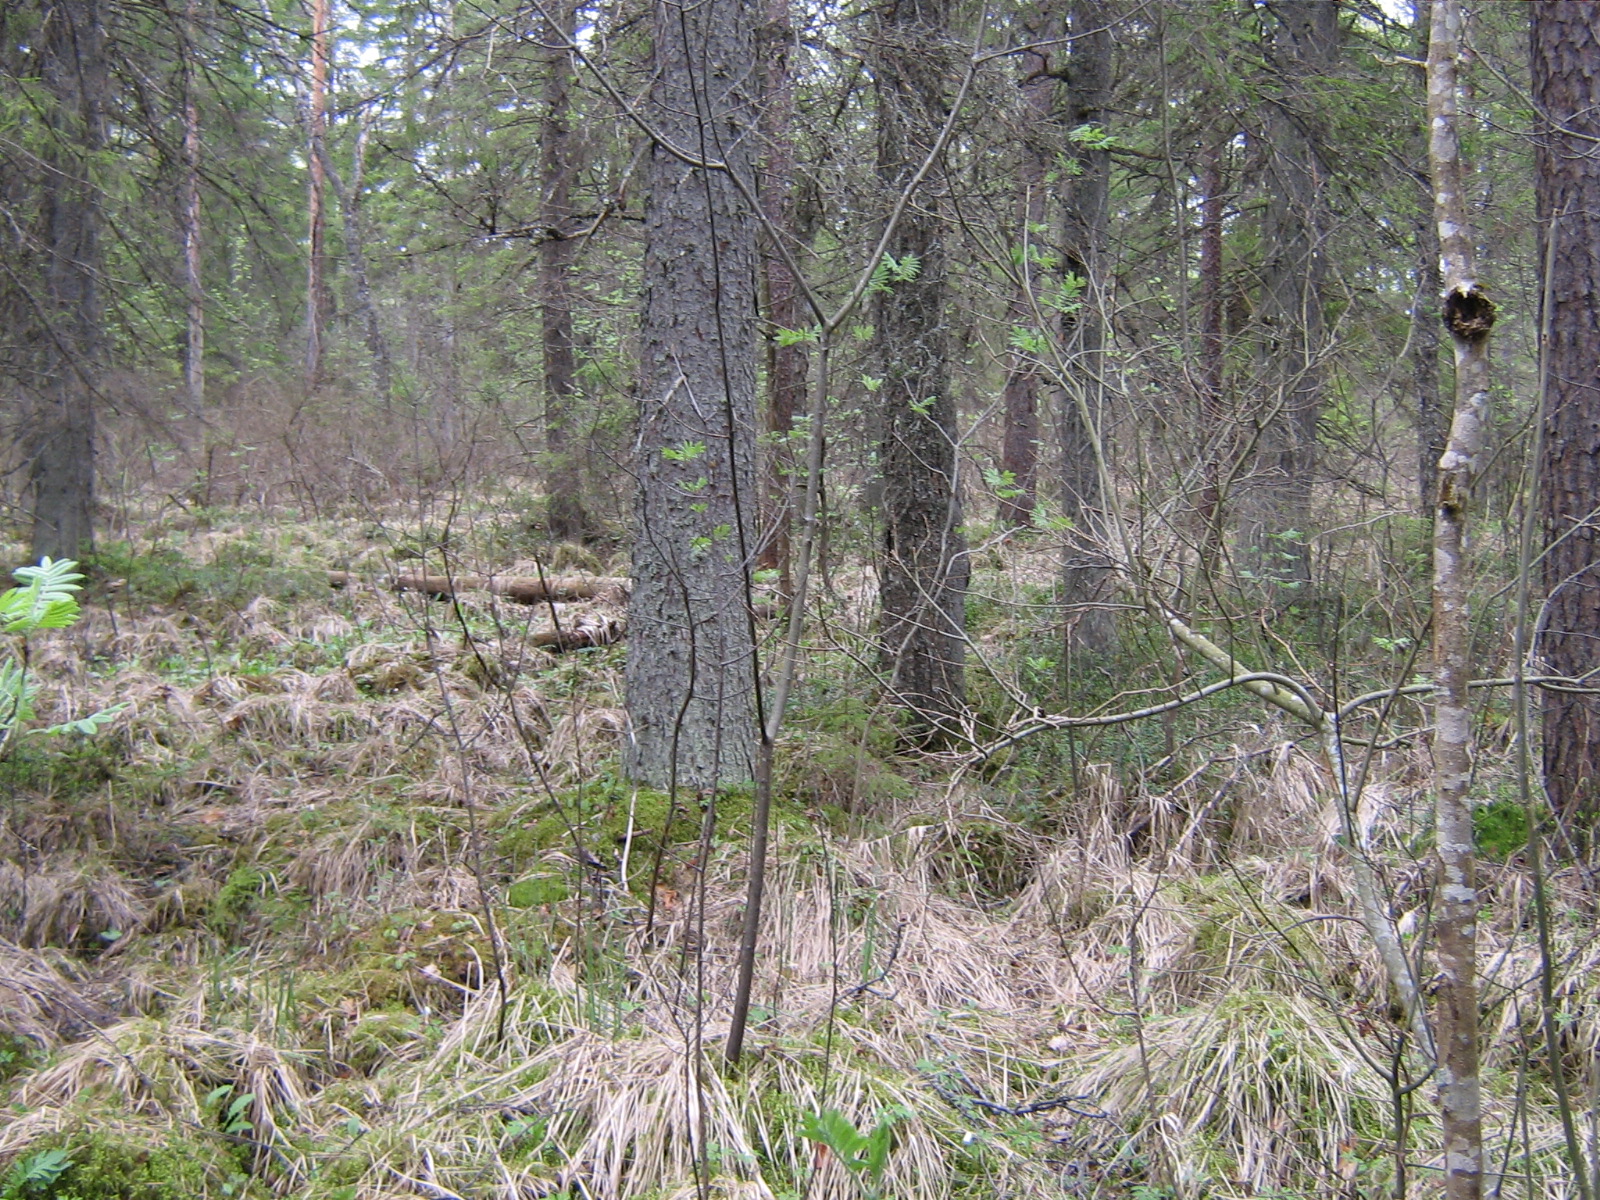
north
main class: Woodland
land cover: Spruce dominated mixed woodland
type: hemiboreal forest and nemoral coniferous forest and mixed broadleaved-coniferous forest
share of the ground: > 75 %
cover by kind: coniferous forest trees 75 %, broadleaved forest trees 25 %
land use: Forestry
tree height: > 5 m
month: May
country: LV
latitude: 57.1342
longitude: 25.2958
